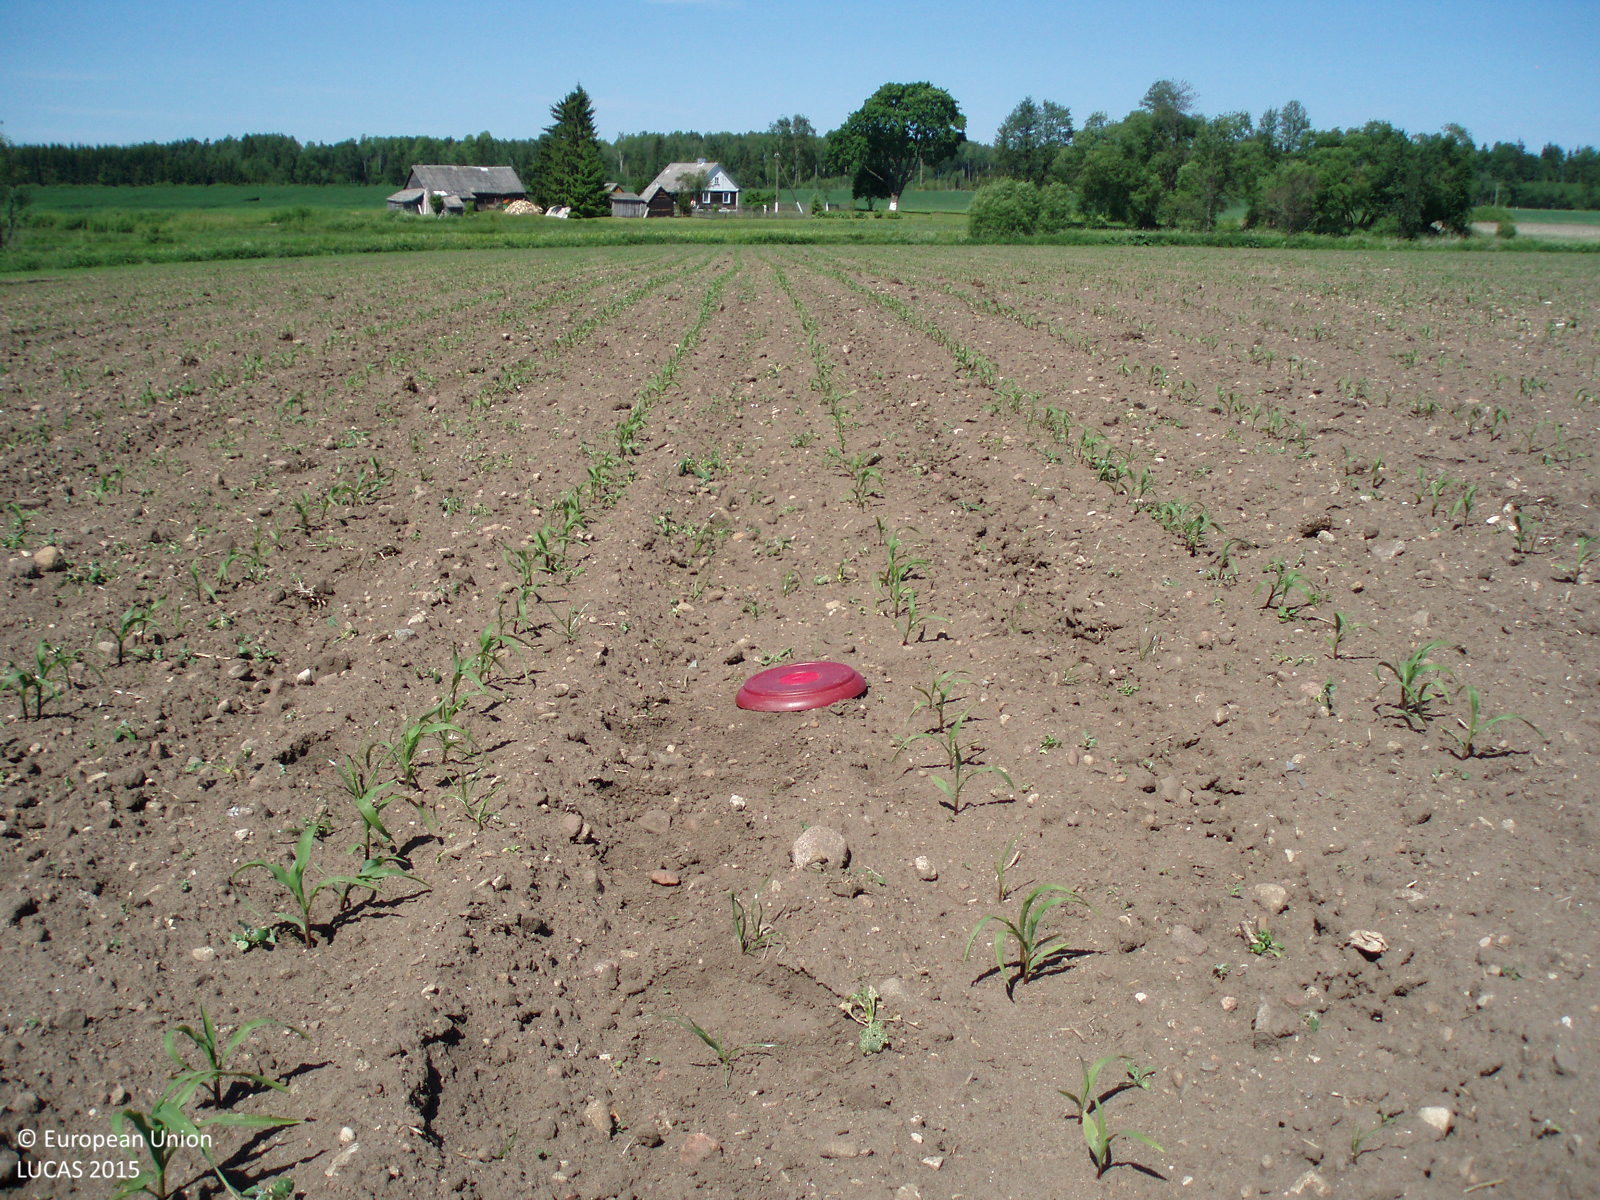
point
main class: Cropland
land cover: Maize
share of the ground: < 10 %
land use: Agriculture (excluding fallow land and kitchen gardens)
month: June
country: LT
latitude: 56.0332
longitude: 22.8231
